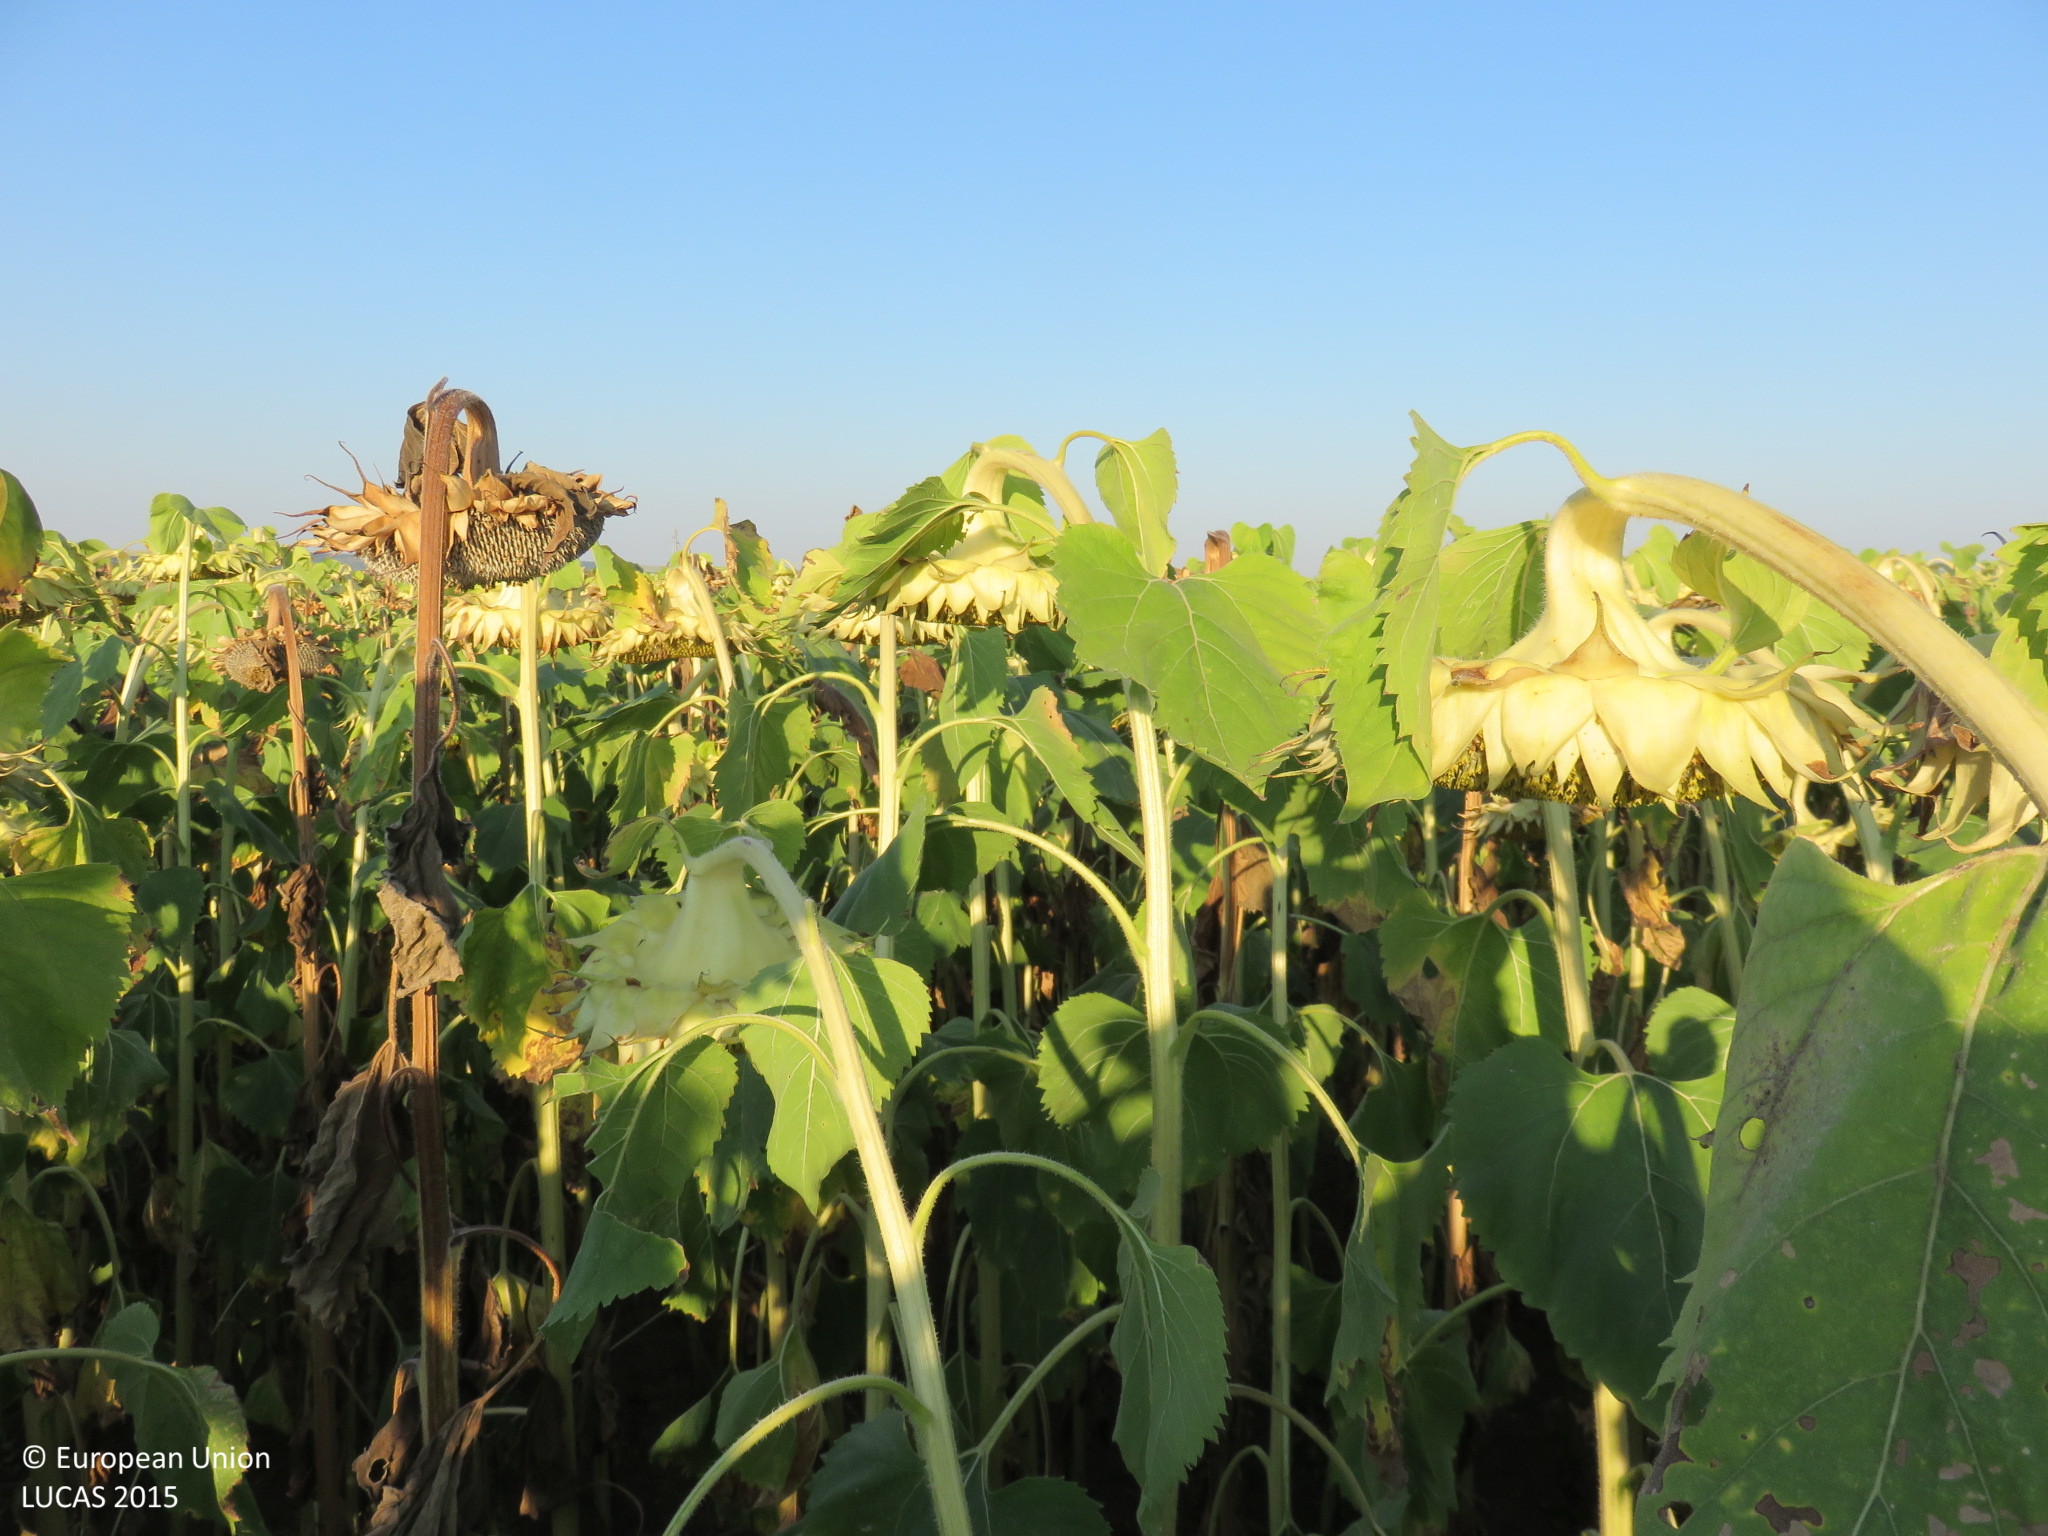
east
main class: Cropland
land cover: Sunflower
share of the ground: > 75 %
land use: Agriculture (excluding fallow land and kitchen gardens)
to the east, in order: Sunflower; Common wheat
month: July
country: BG
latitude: 43.3642
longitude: 25.1143
